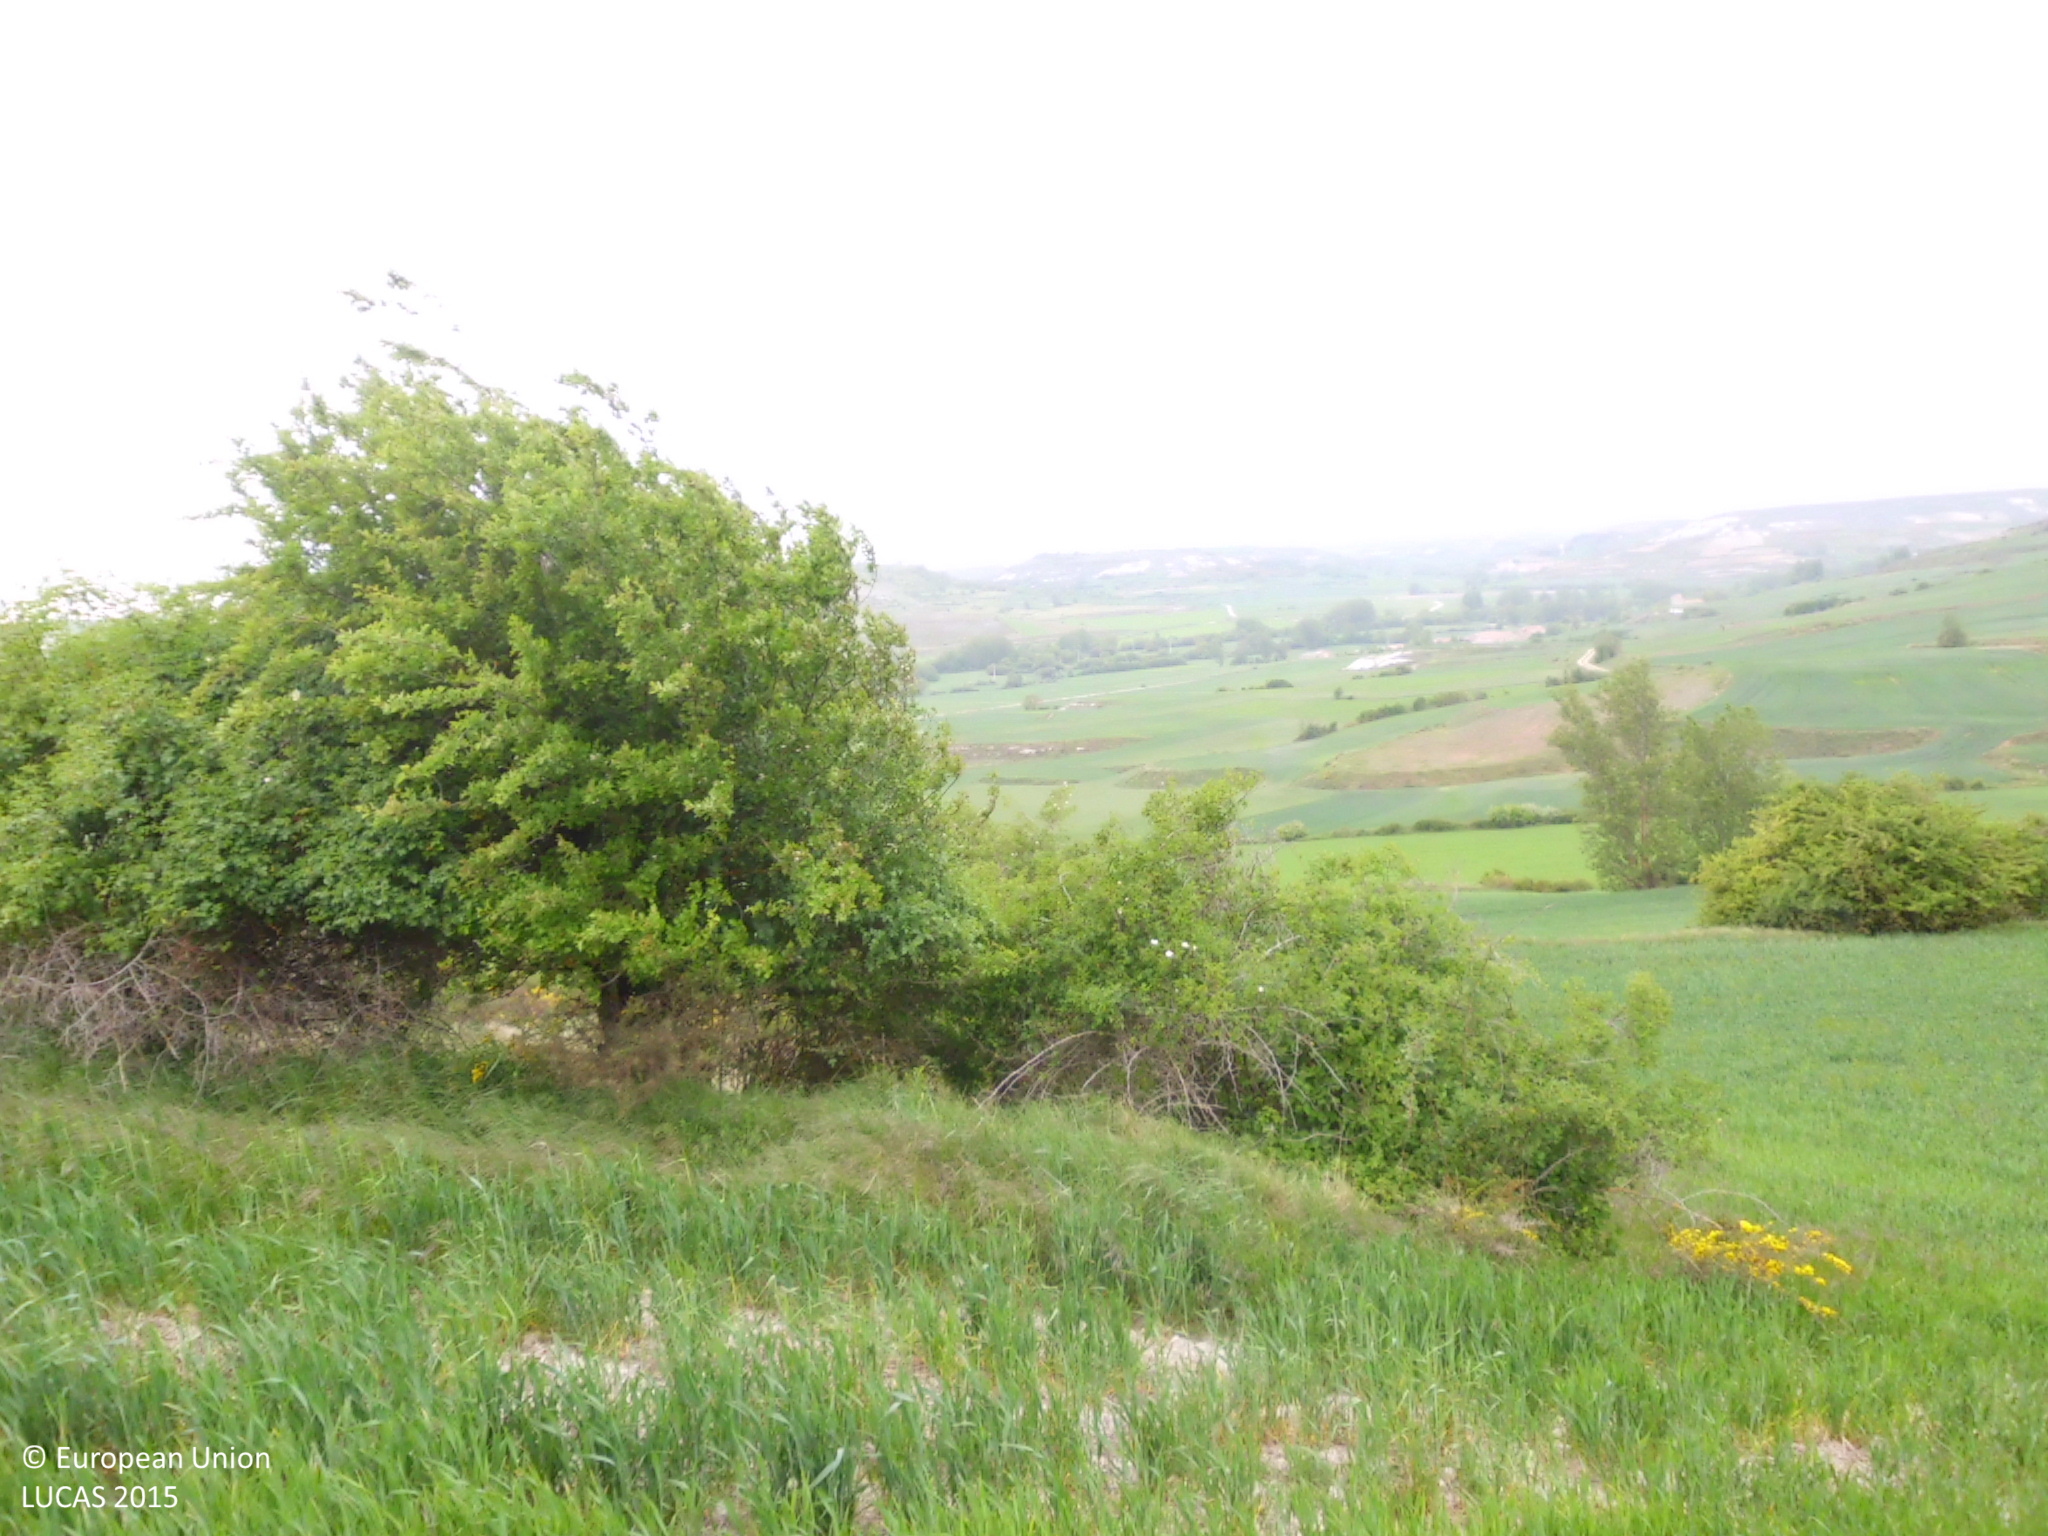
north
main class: Cropland
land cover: Common wheat
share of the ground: > 75 %
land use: Agriculture (excluding fallow land and kitchen gardens)
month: May
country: ES
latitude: 42.4555
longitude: -3.7917
